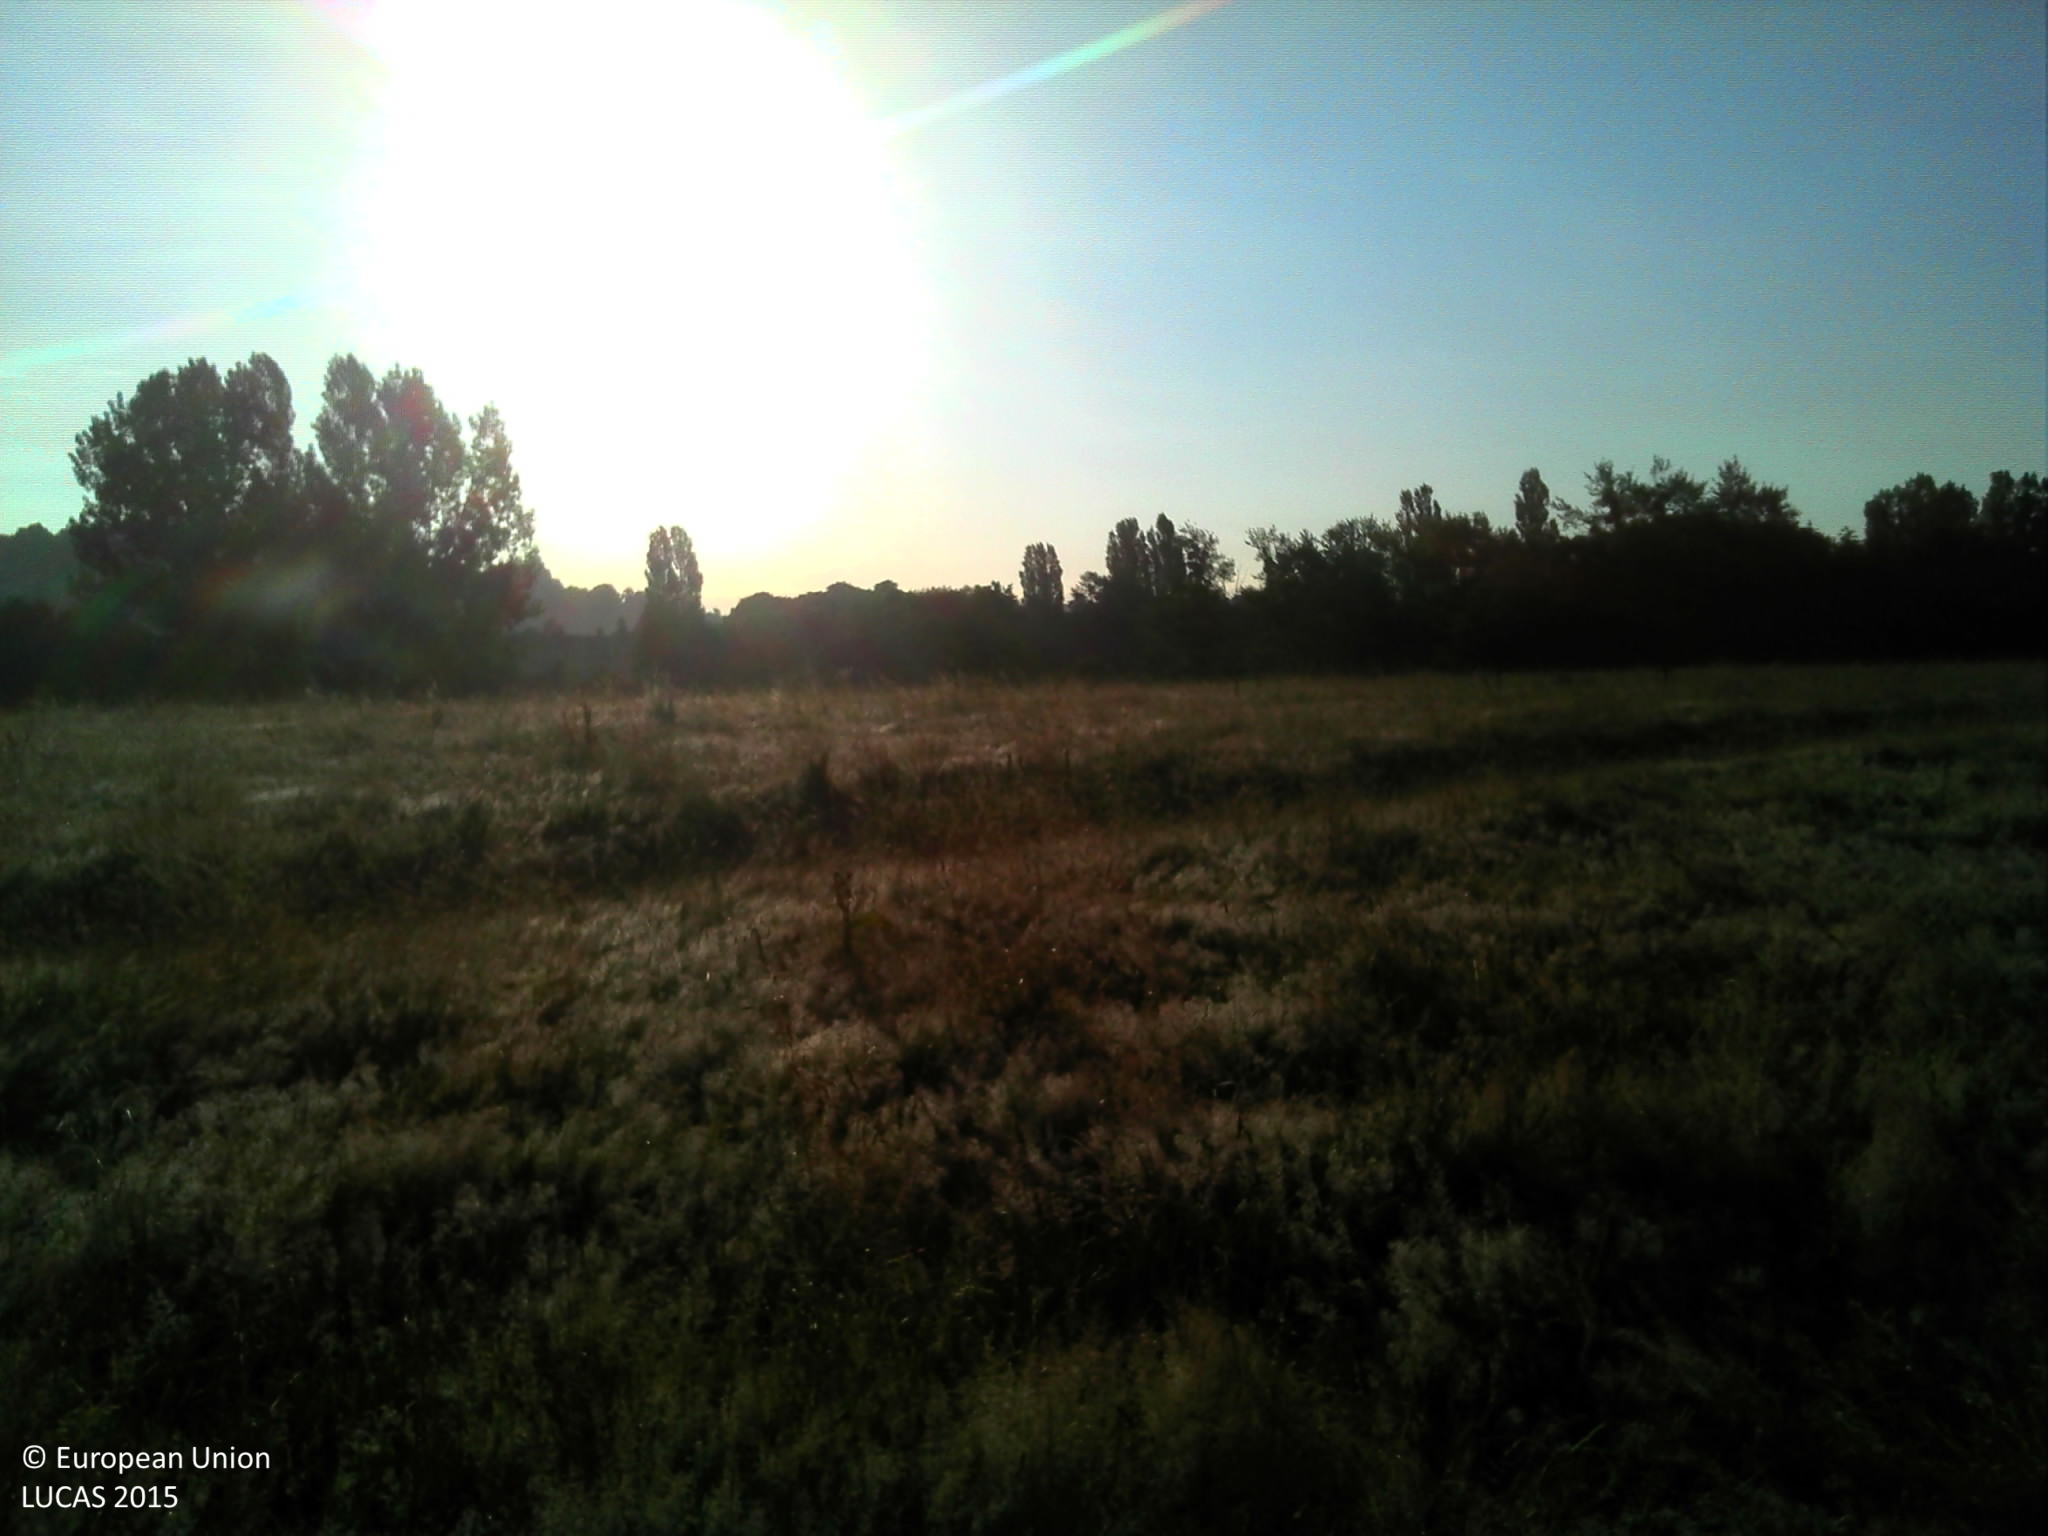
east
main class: Grassland
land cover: Grassland without tree/shrub cover
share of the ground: > 75 %
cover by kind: herbaceous plants 100 %
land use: Agriculture (excluding fallow land and kitchen gardens)
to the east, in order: Grassland without tree/shrub cover; Fences; Inland fresh running water; Broadleaved woodland; Grassland without tree/shrub cover
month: July
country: FR
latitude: 49.0793
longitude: 0.0715
